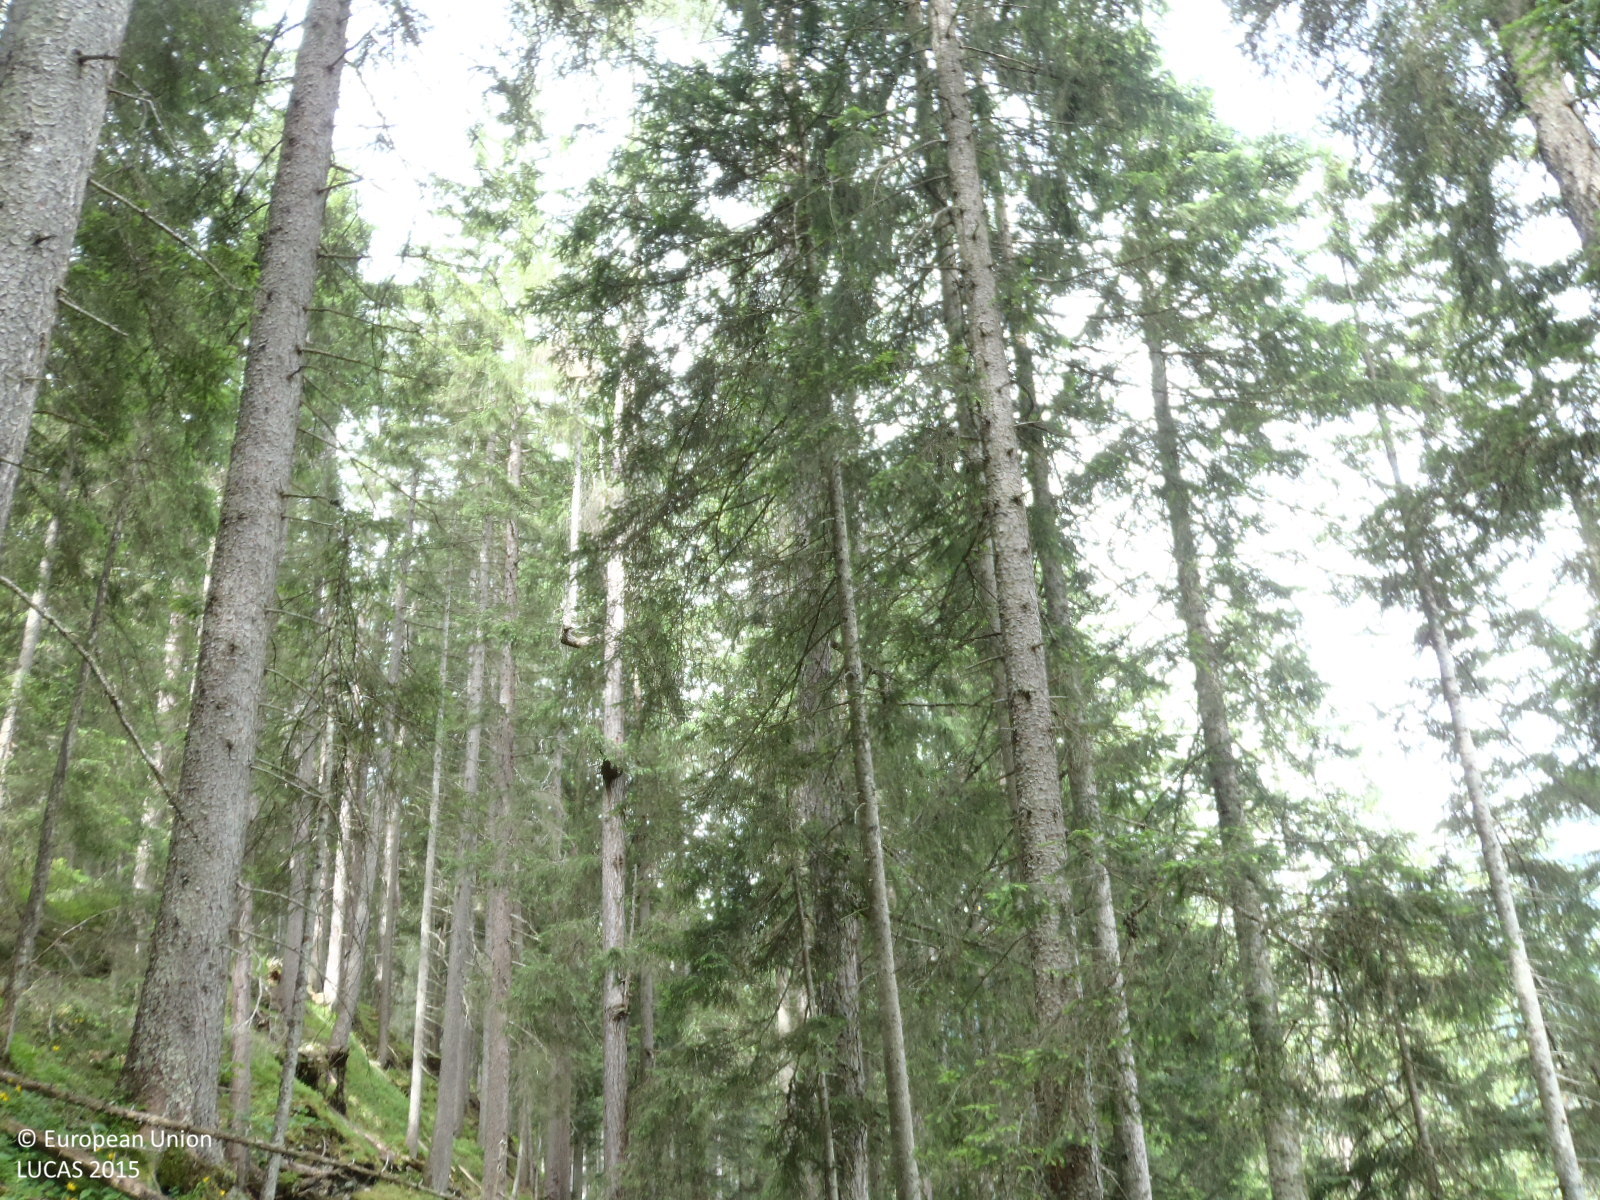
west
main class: Woodland
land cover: Other coniferous woodland
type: alpine coniferous forest
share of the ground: > 75 %
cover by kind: coniferous forest trees 80 %, shrubs 10 %, herbaceous plants 10 %
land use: Forestry
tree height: > 5 m
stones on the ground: < 10 %
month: June
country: AT
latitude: 47.2866
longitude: 10.4623
